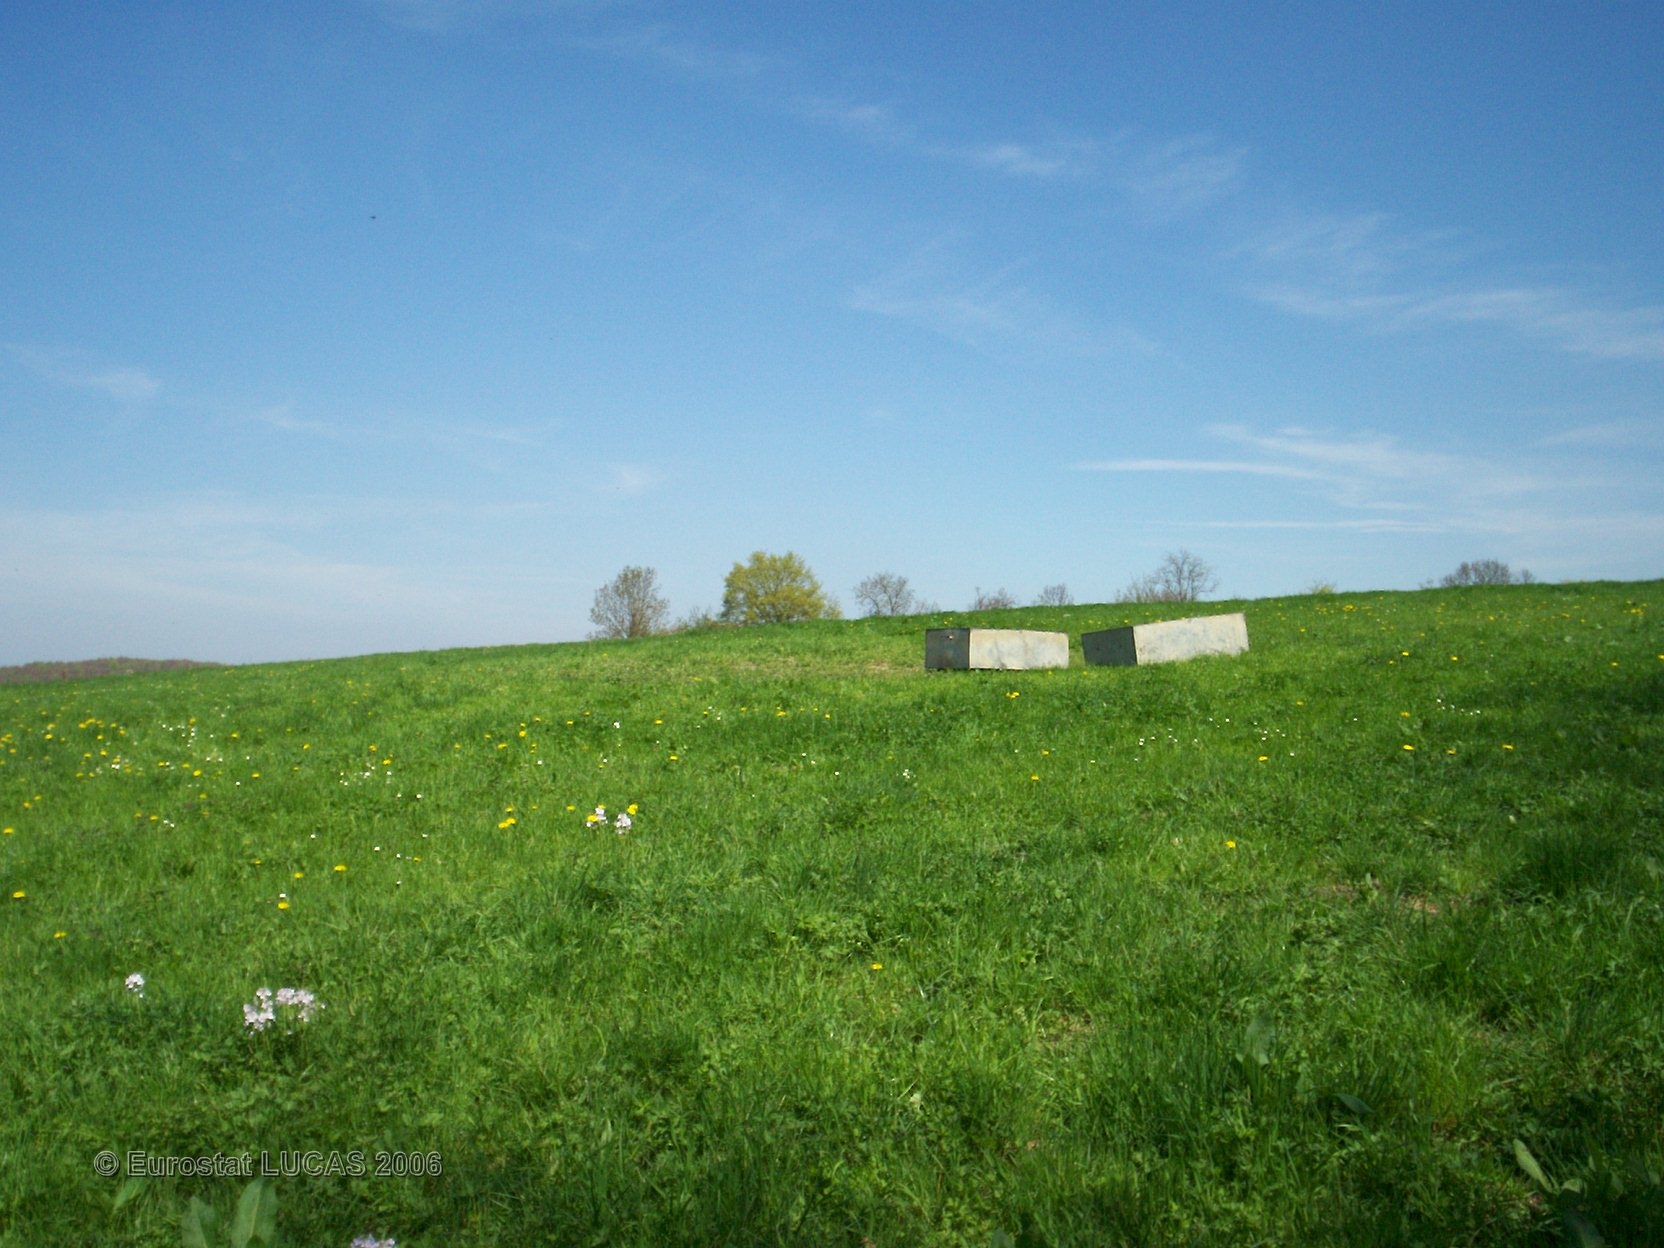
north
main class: Grassland
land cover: Grassland without tree/shrub cover
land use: Agriculture (excluding fallow land and kitchen gardens)
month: April
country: FR
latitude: 49.6673
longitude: 4.3844
